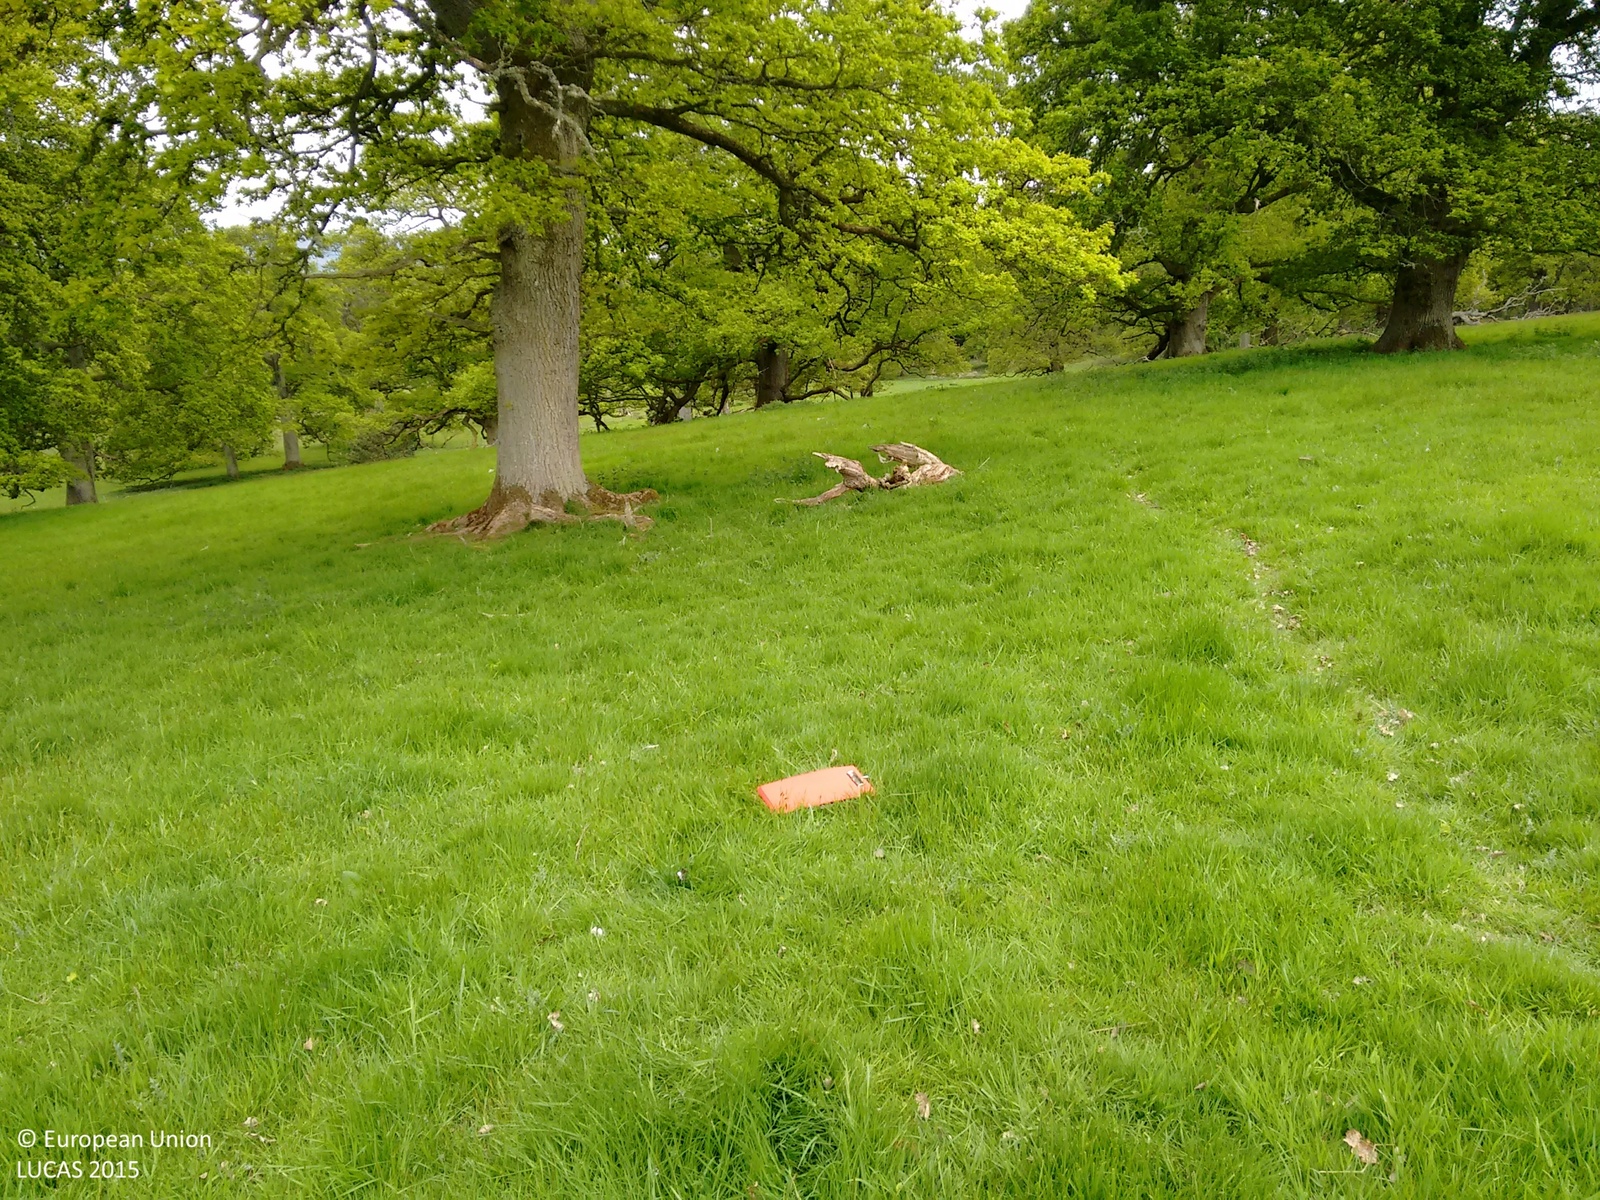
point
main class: Woodland
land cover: Broadleaved woodland
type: exotic forest
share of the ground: 10 - 25 %
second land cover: Grassland without tree/shrub cover
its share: > 75 %
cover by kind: herbaceous plants 80 %, broadleaved forest trees 20 %
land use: Agriculture (excluding fallow land and kitchen gardens)
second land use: Forestry
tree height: > 5 m
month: May
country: GB
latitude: 56.3619
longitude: -3.5272
